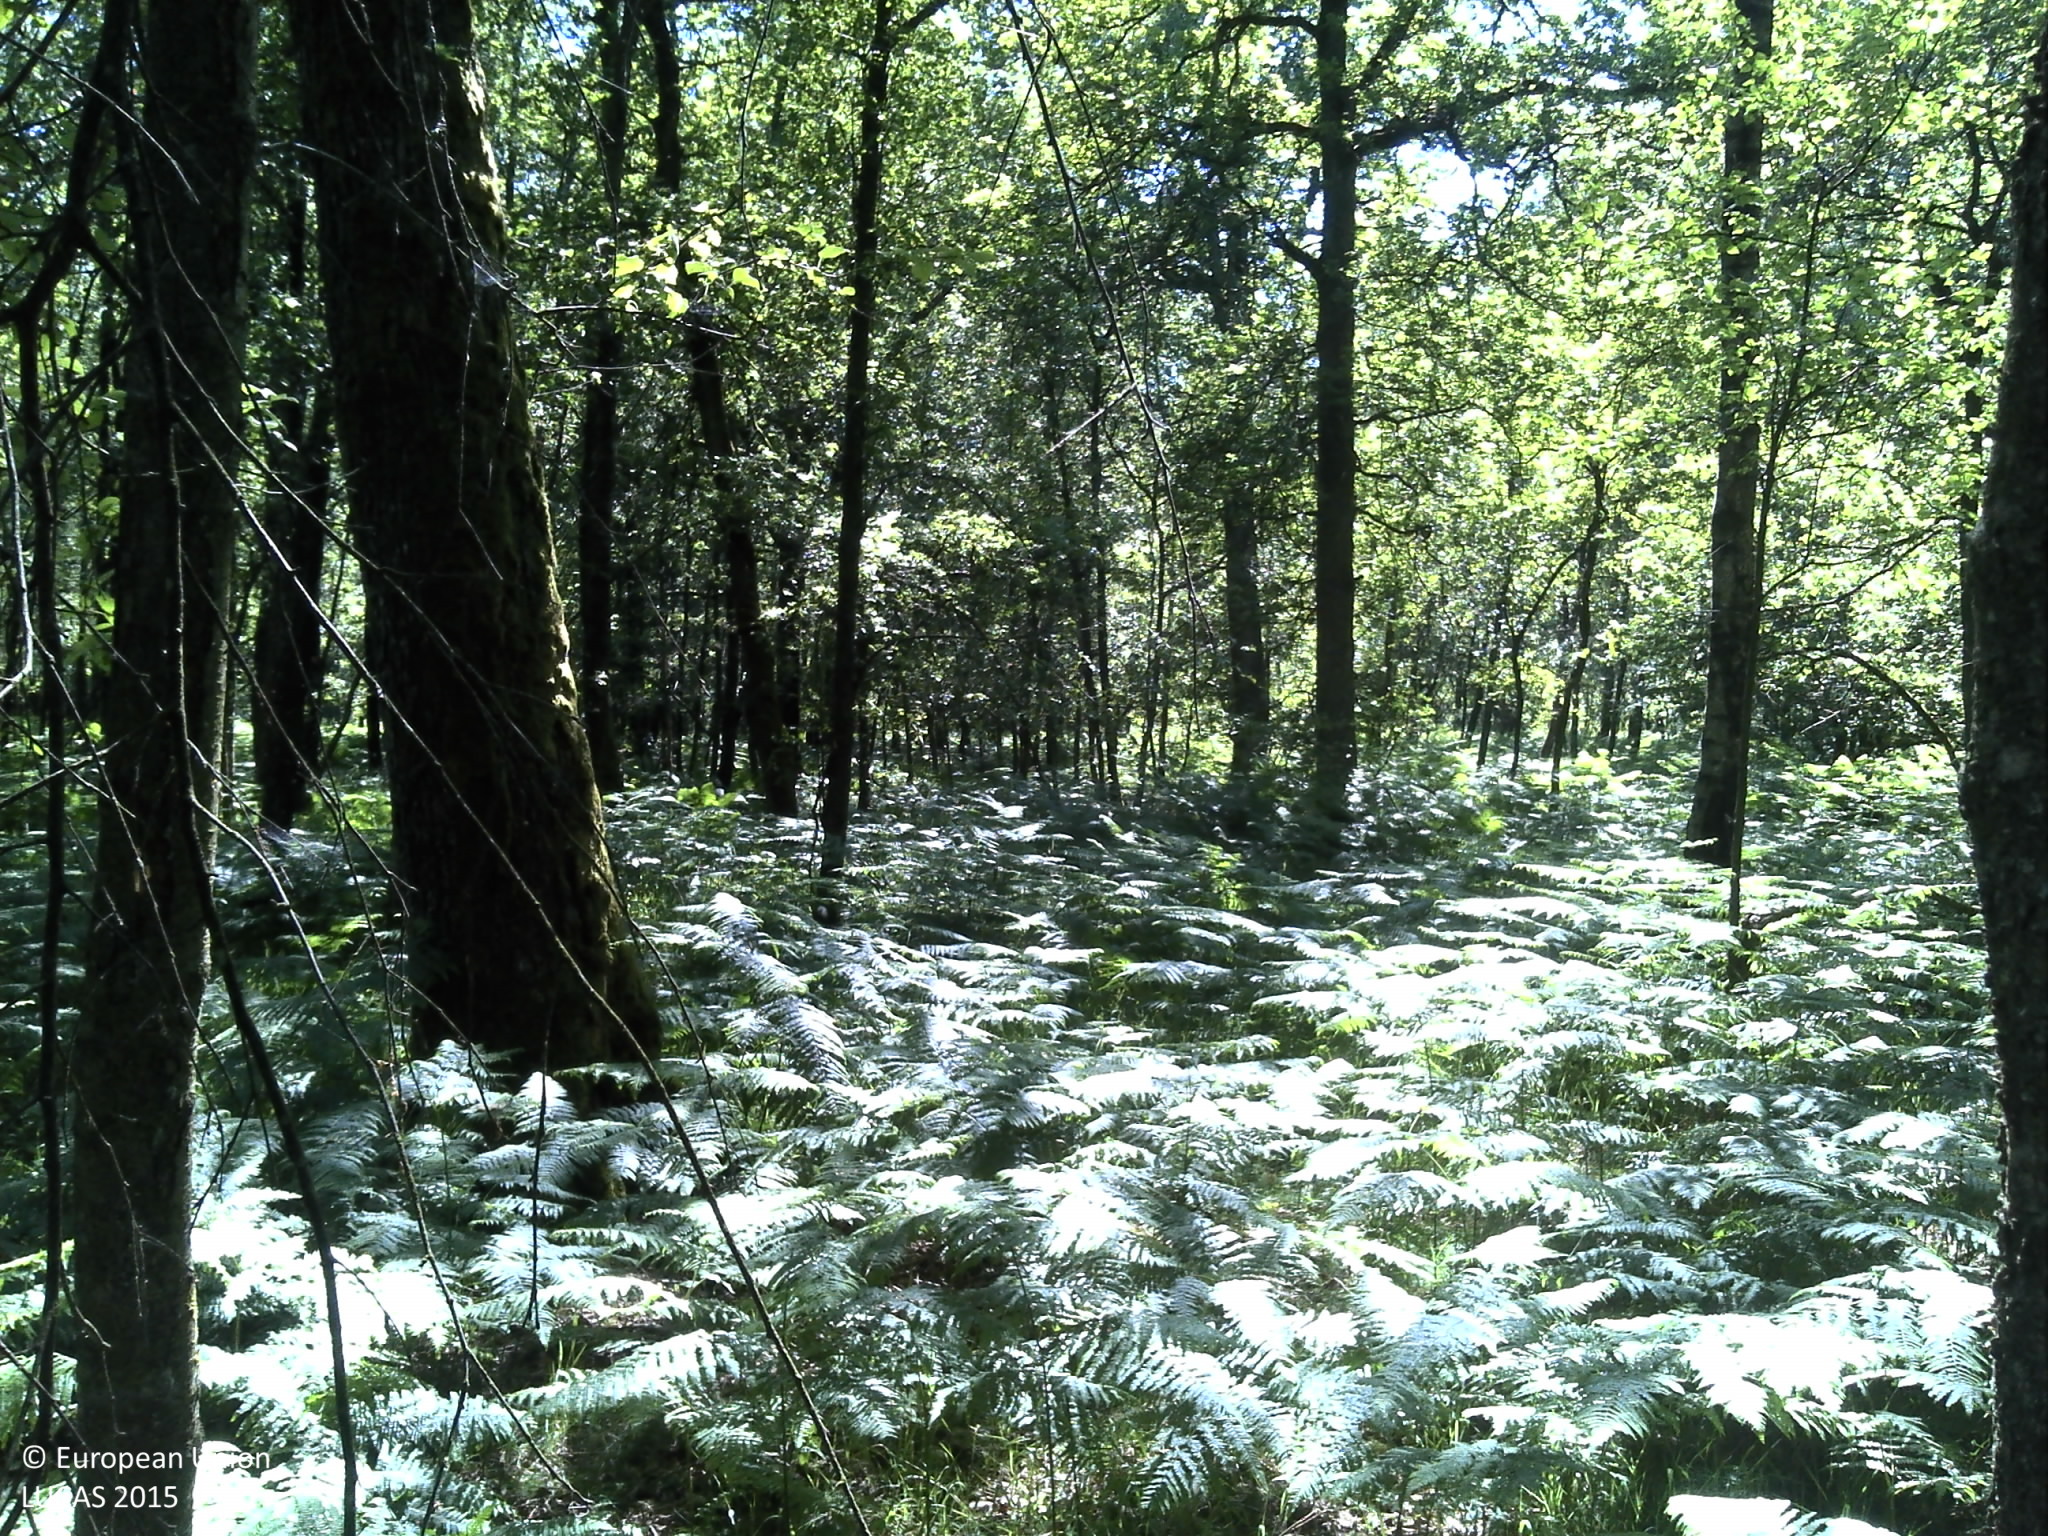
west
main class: Woodland
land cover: Broadleaved woodland
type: acidophilous oak and oak-birch forest
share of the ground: 25 - 50 %
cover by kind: broadleaved forest trees 65 %, herbaceous plants 25 %, consolidated bare surface 10 %
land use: Forestry
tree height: > 5 m
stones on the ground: 10 - 25 %
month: June
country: FR
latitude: 49.9933
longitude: 4.7938
